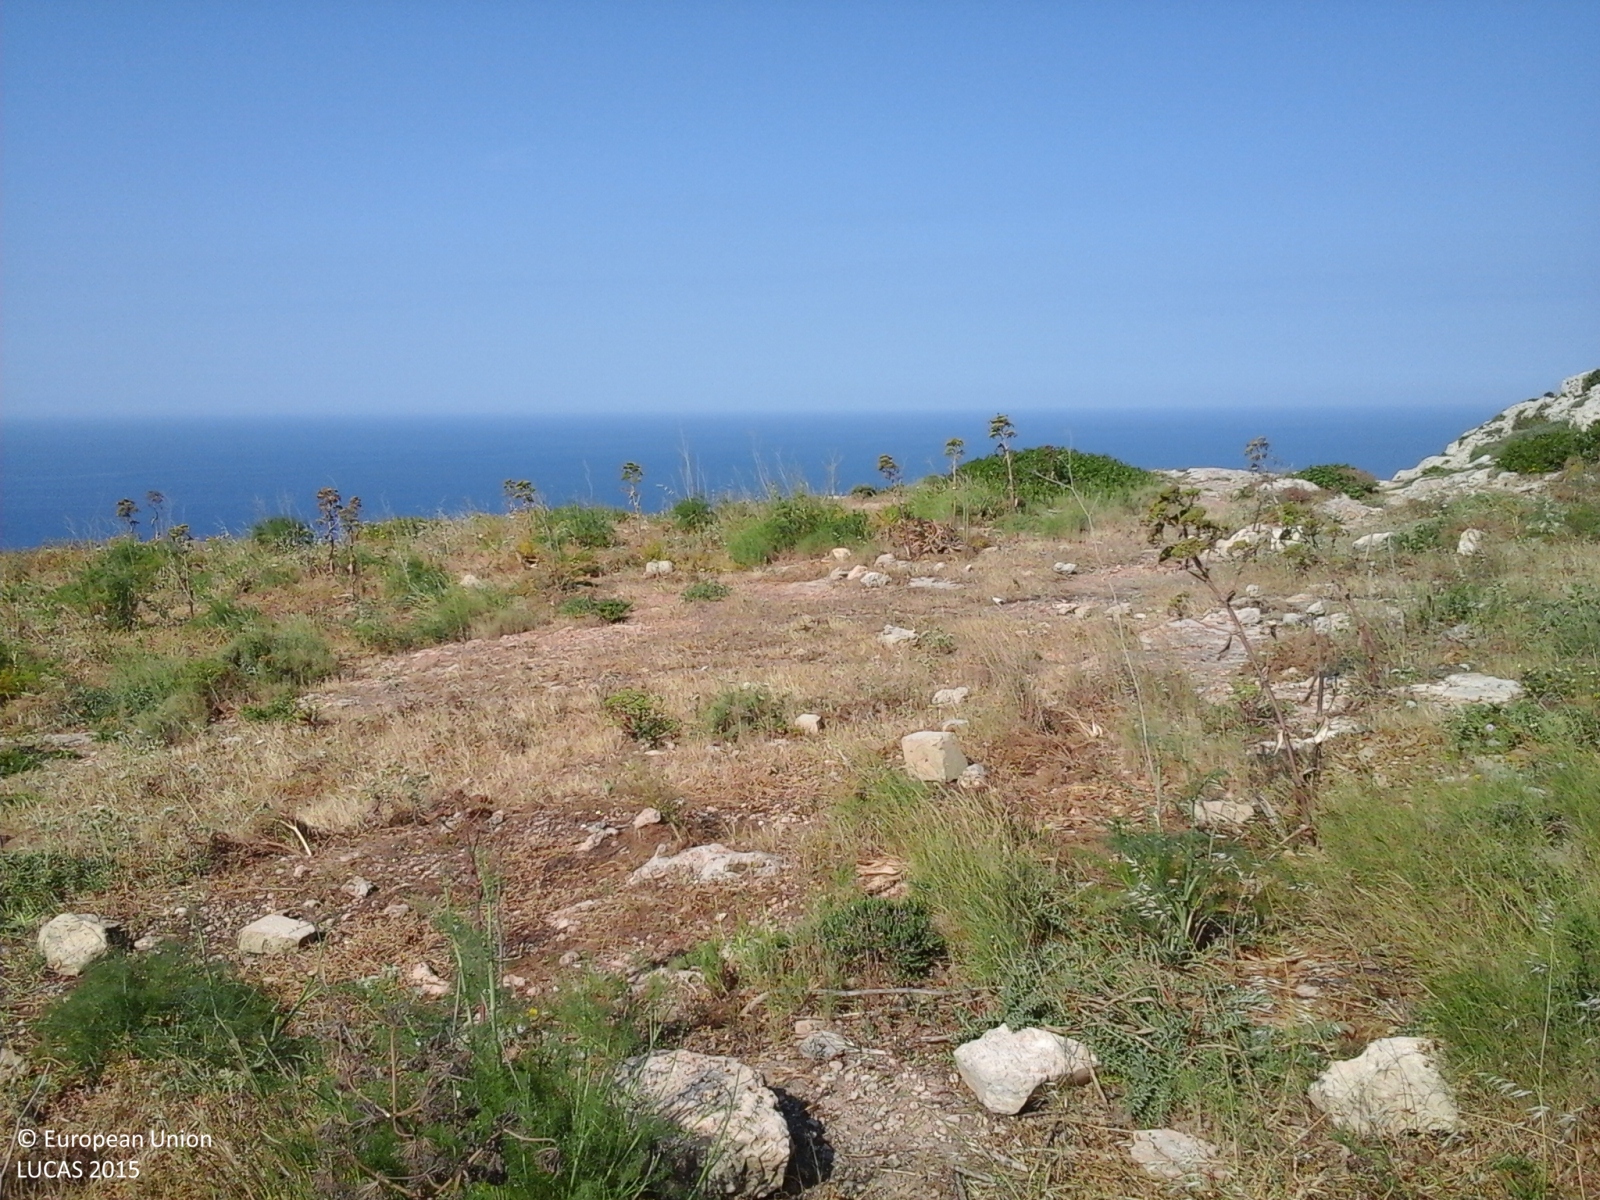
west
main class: Grassland
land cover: Grassland without tree/shrub cover
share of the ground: 50 - 75 %
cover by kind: herbaceous plants 50 %, consolidated bare surface 50 %
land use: Semi-natural and natural areas not in use
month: May
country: MT
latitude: 35.8442
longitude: 14.3988
